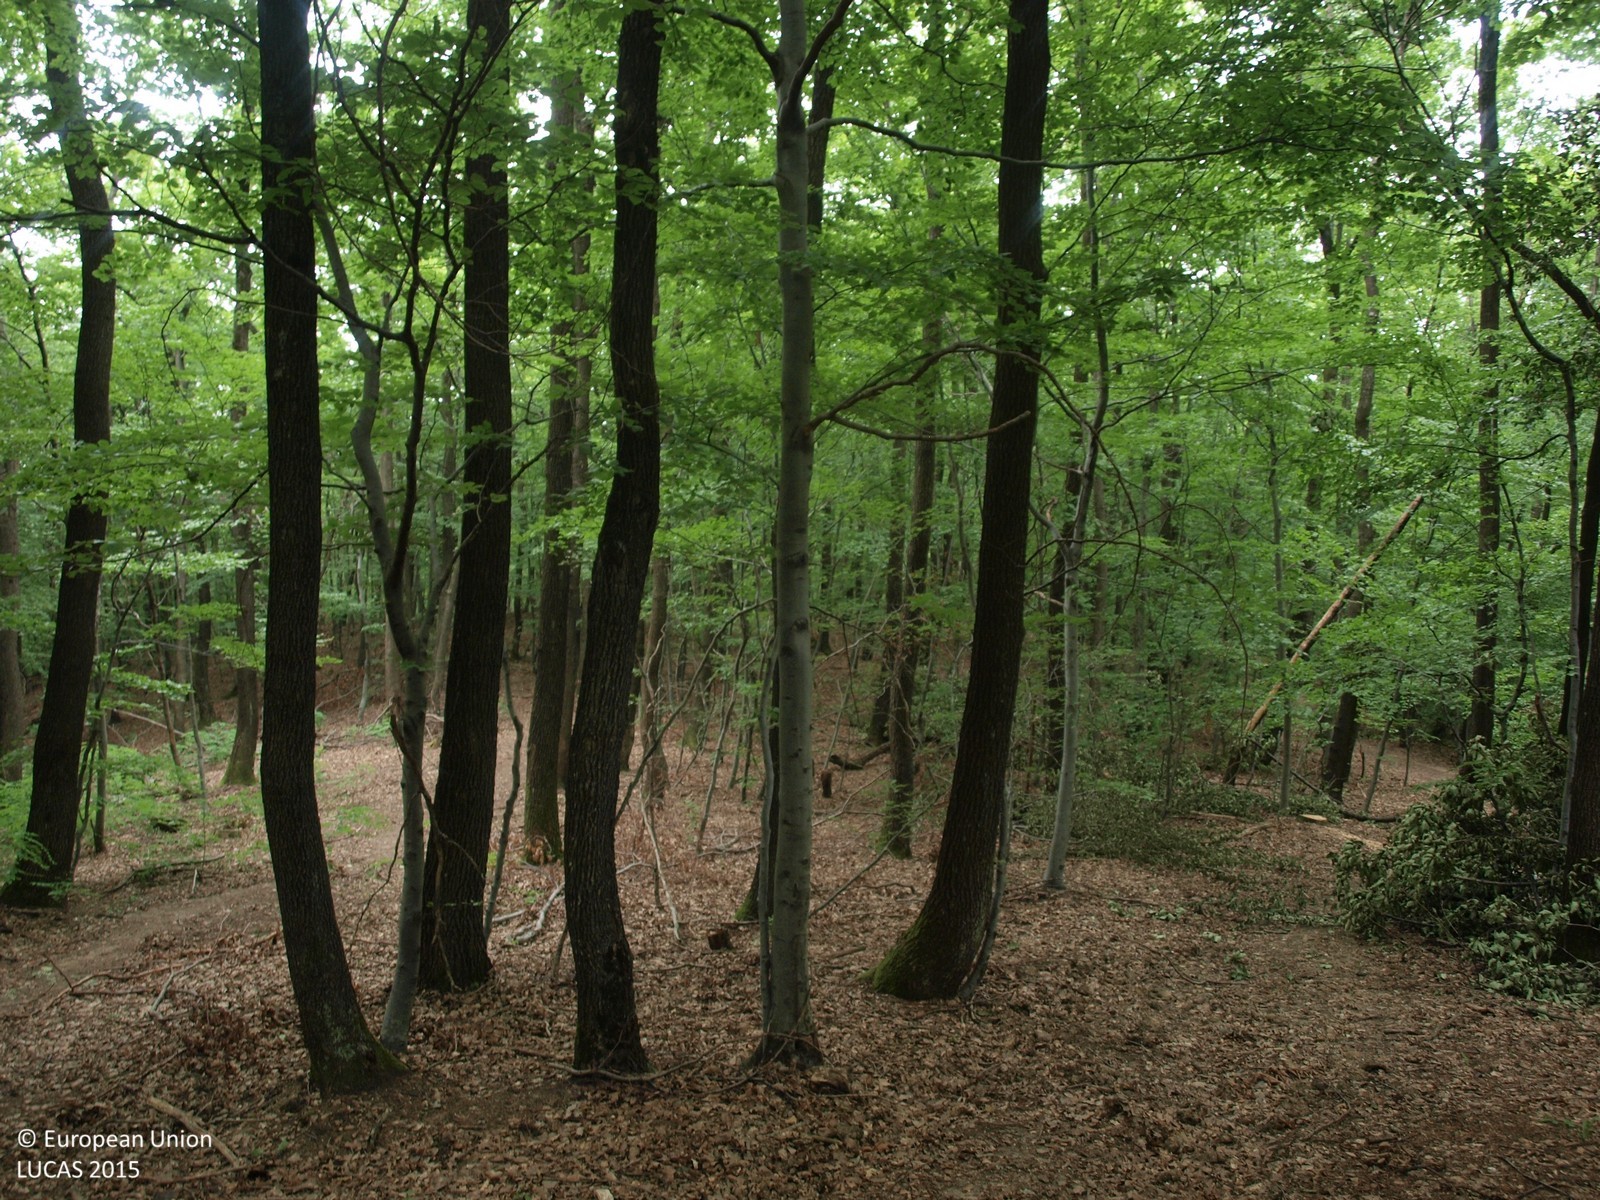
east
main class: Woodland
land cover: Broadleaved woodland
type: mesophytic deciduous forest
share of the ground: > 75 %
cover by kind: broadleaved forest trees 100 %
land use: Forestry
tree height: > 5 m
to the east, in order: Broadleaved woodland; Tracks; Broadleaved woodland
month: August
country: HR
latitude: 45.8447
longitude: 15.9081
